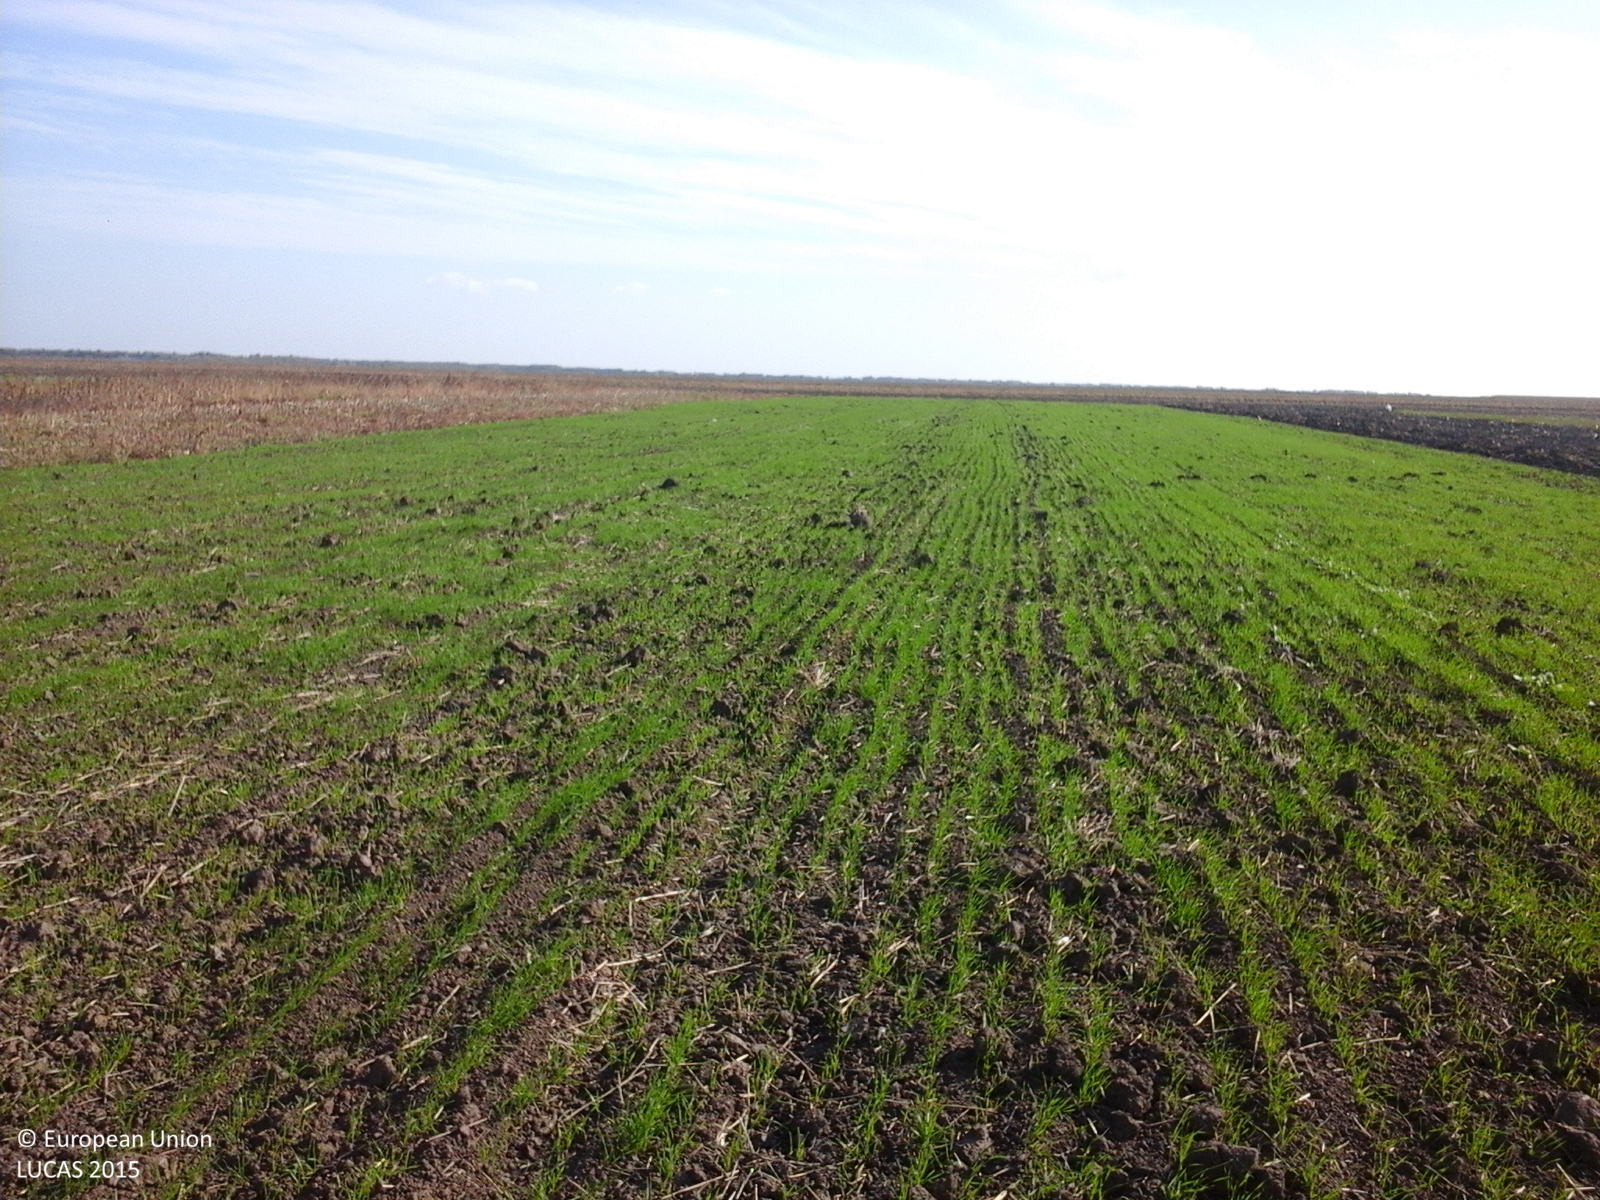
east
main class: Cropland
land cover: Common wheat
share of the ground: 10 - 25 %
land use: Agriculture (excluding fallow land and kitchen gardens)
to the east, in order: Common wheat; Grass margins; Tracks; Grass margins; Other bare soil; Maize; Other bare soil; Sunflower; Lucerne; Other bare soil
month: October
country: RO
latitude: 45.5608
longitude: 27.1445
